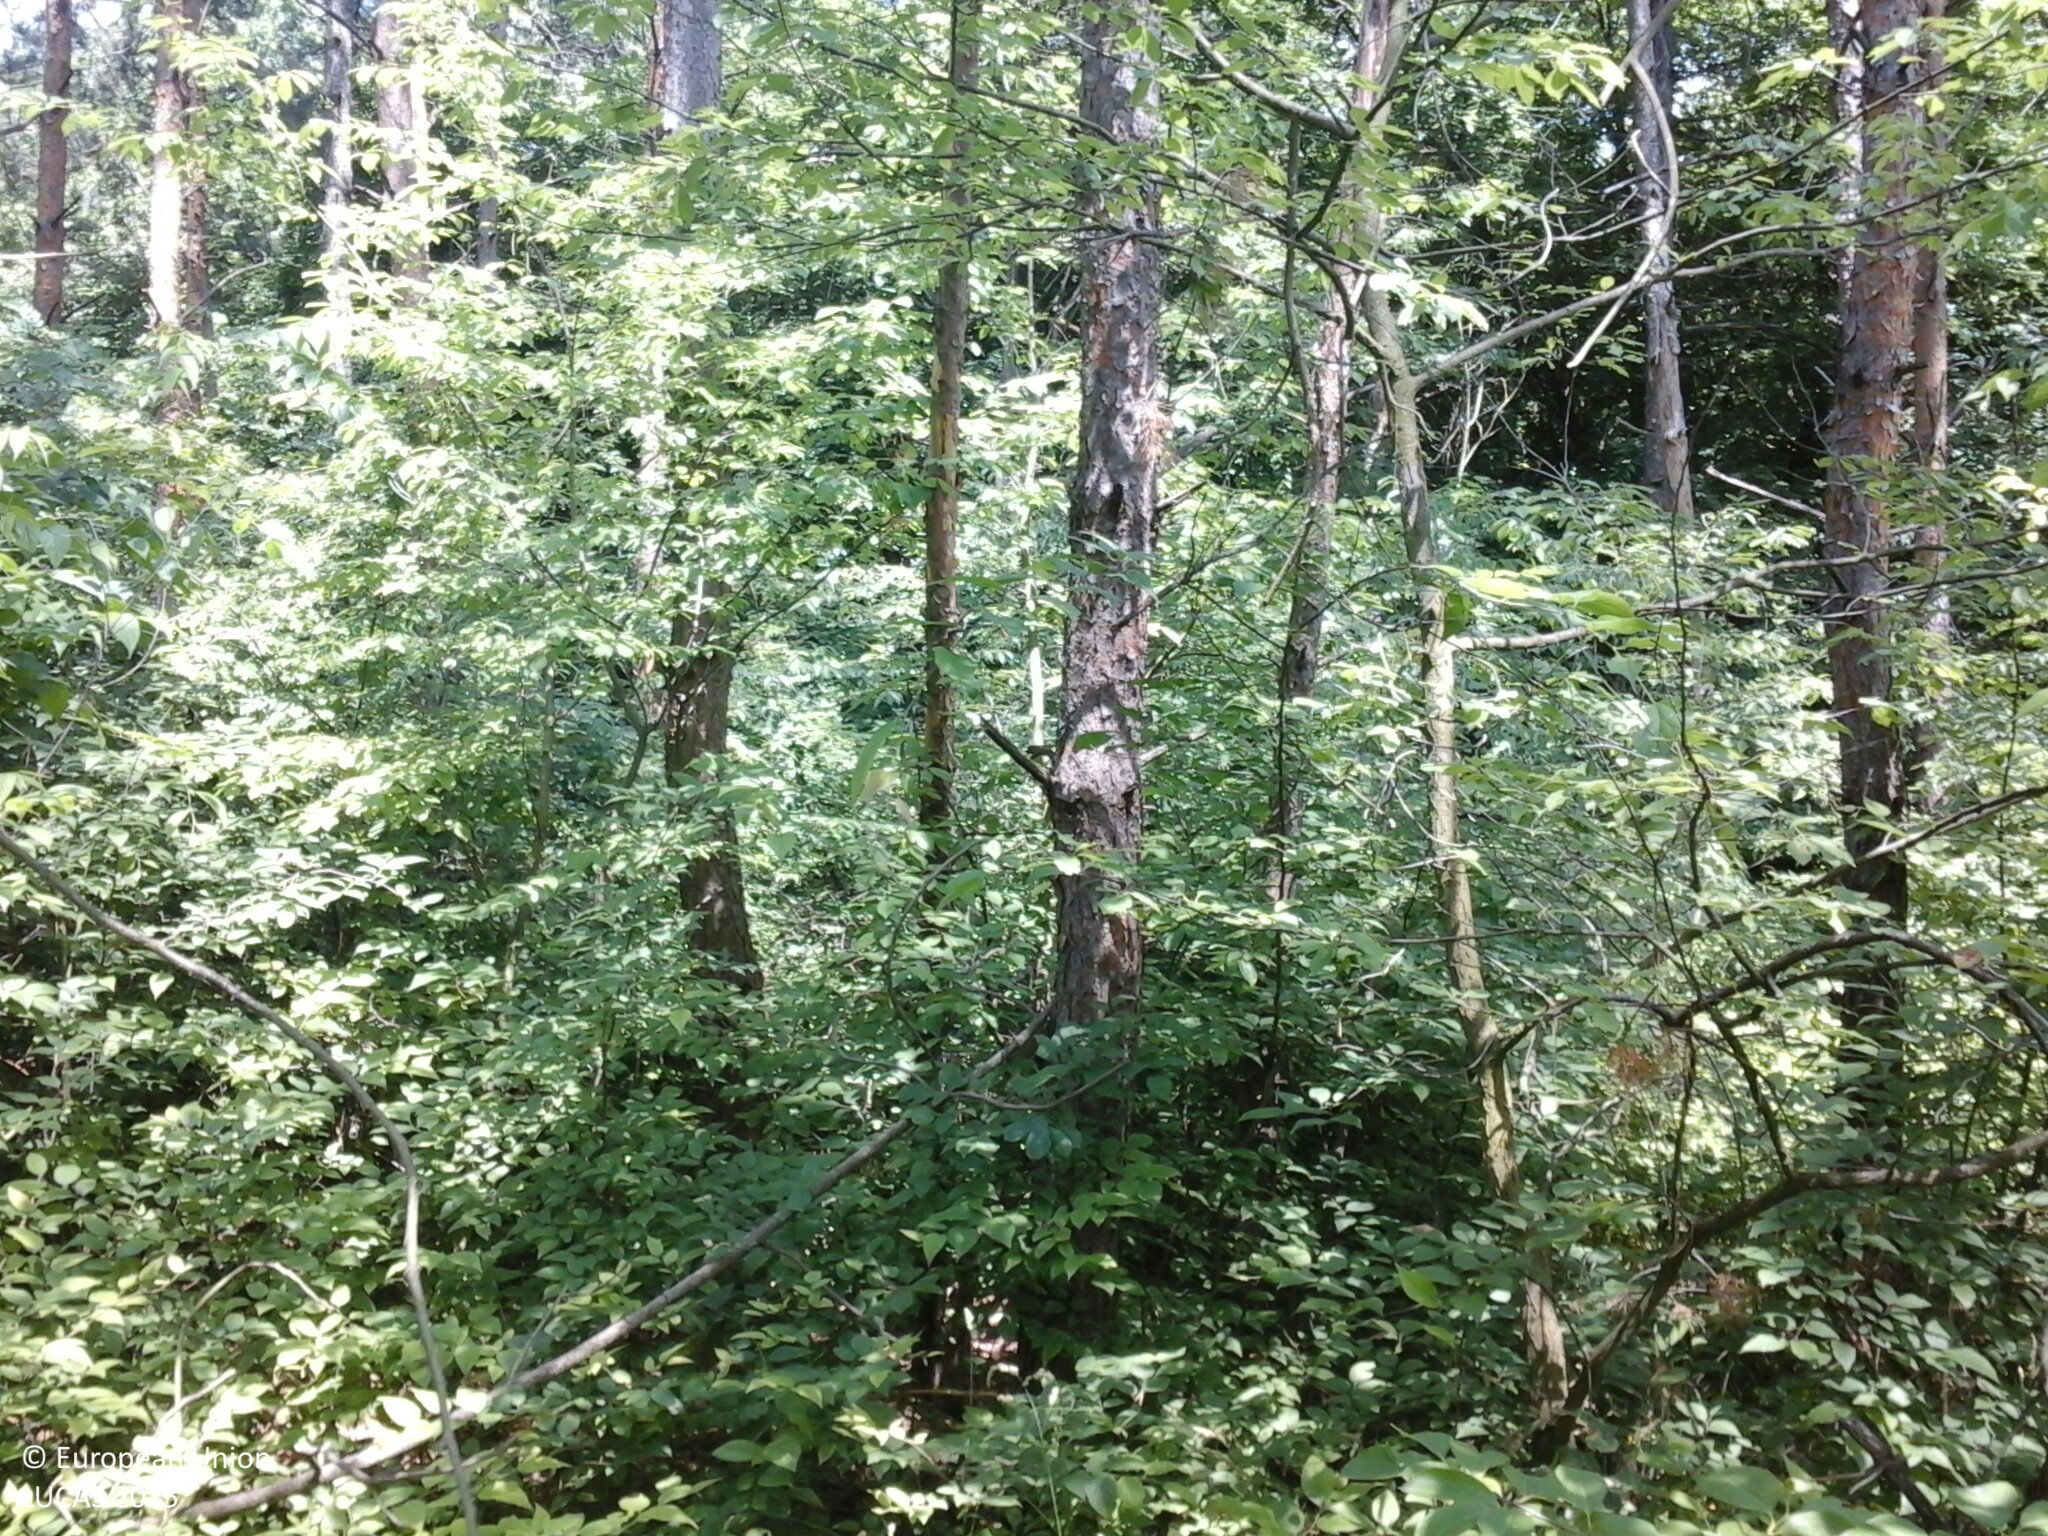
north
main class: Woodland
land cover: Pine dominated coniferous woodland
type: hemiboreal forest and nemoral coniferous forest and mixed broadleaved-coniferous forest
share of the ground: > 75 %
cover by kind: coniferous forest trees 95 %, broadleaved forest trees 5 %
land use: Forestry
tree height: > 5 m
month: June
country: HU
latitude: 47.6372
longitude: 19.4314
